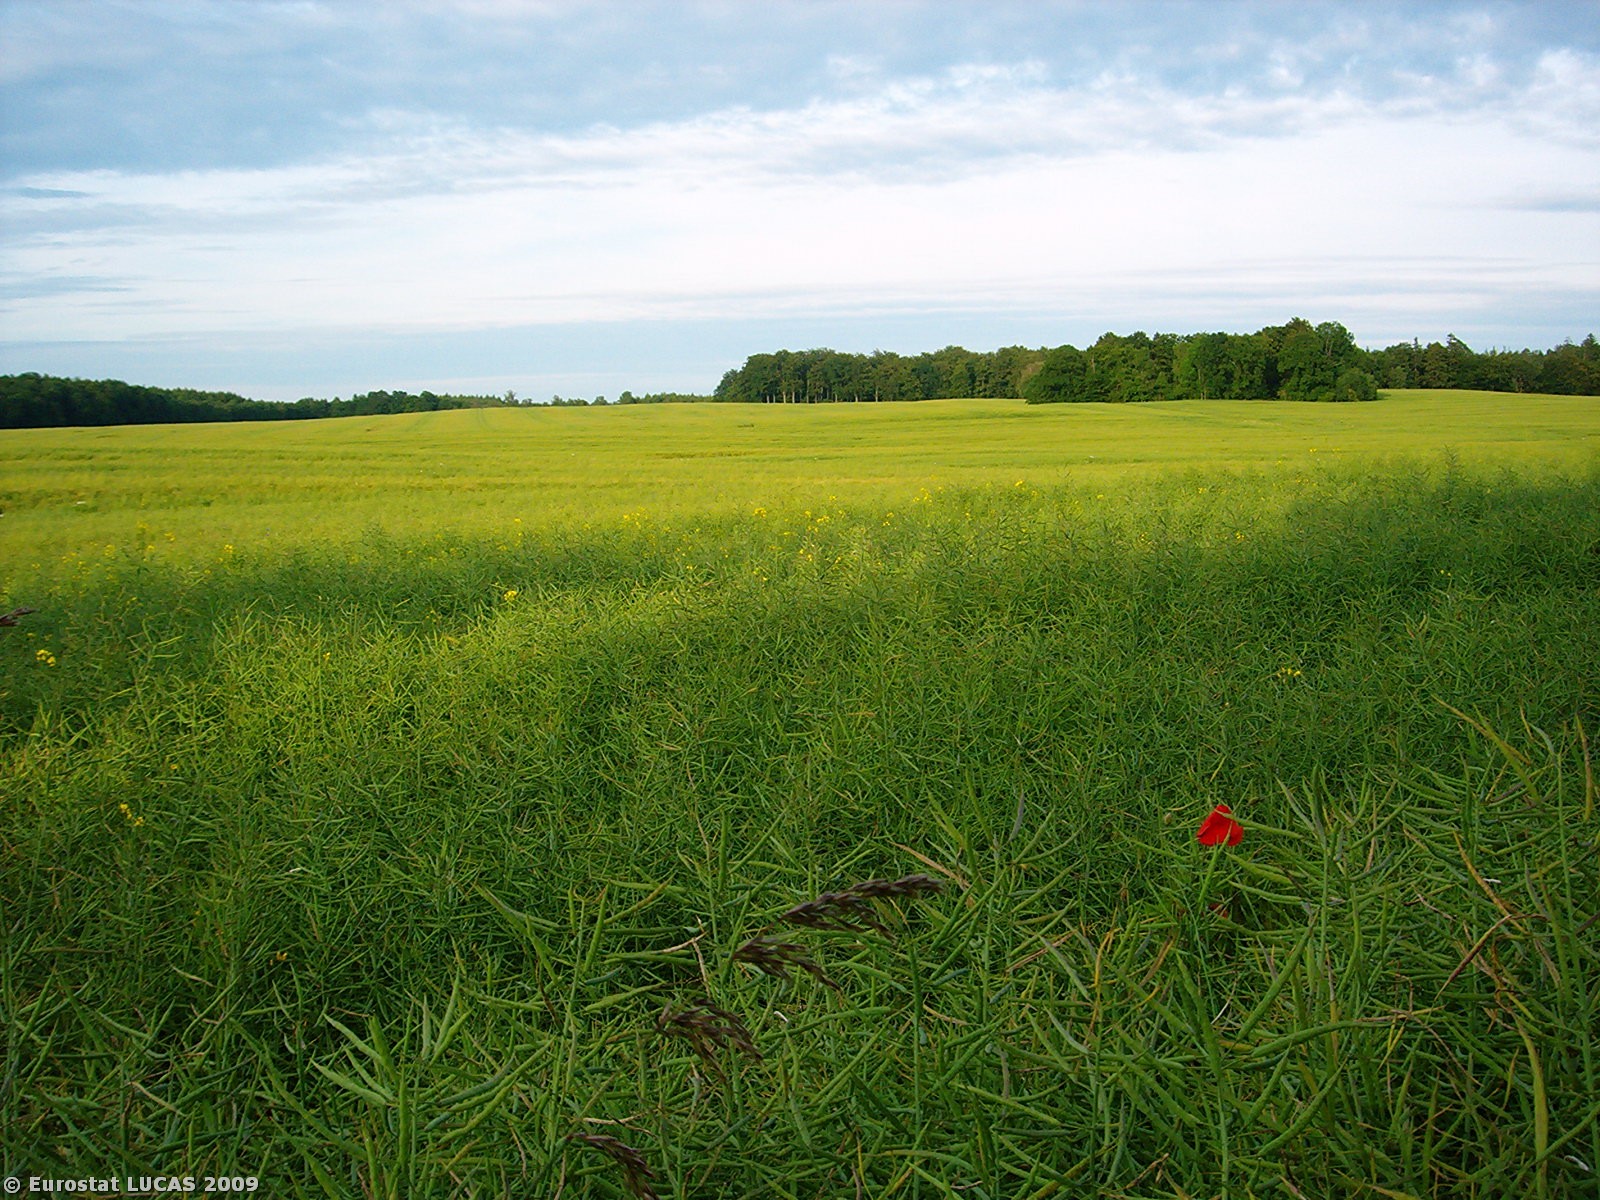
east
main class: Cropland
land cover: Rape and turnip rape
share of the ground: > 75 %
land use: Agriculture (excluding fallow land and kitchen gardens)
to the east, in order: Rape and turnip rape
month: June
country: PL
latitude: 54.0206
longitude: 15.3905
